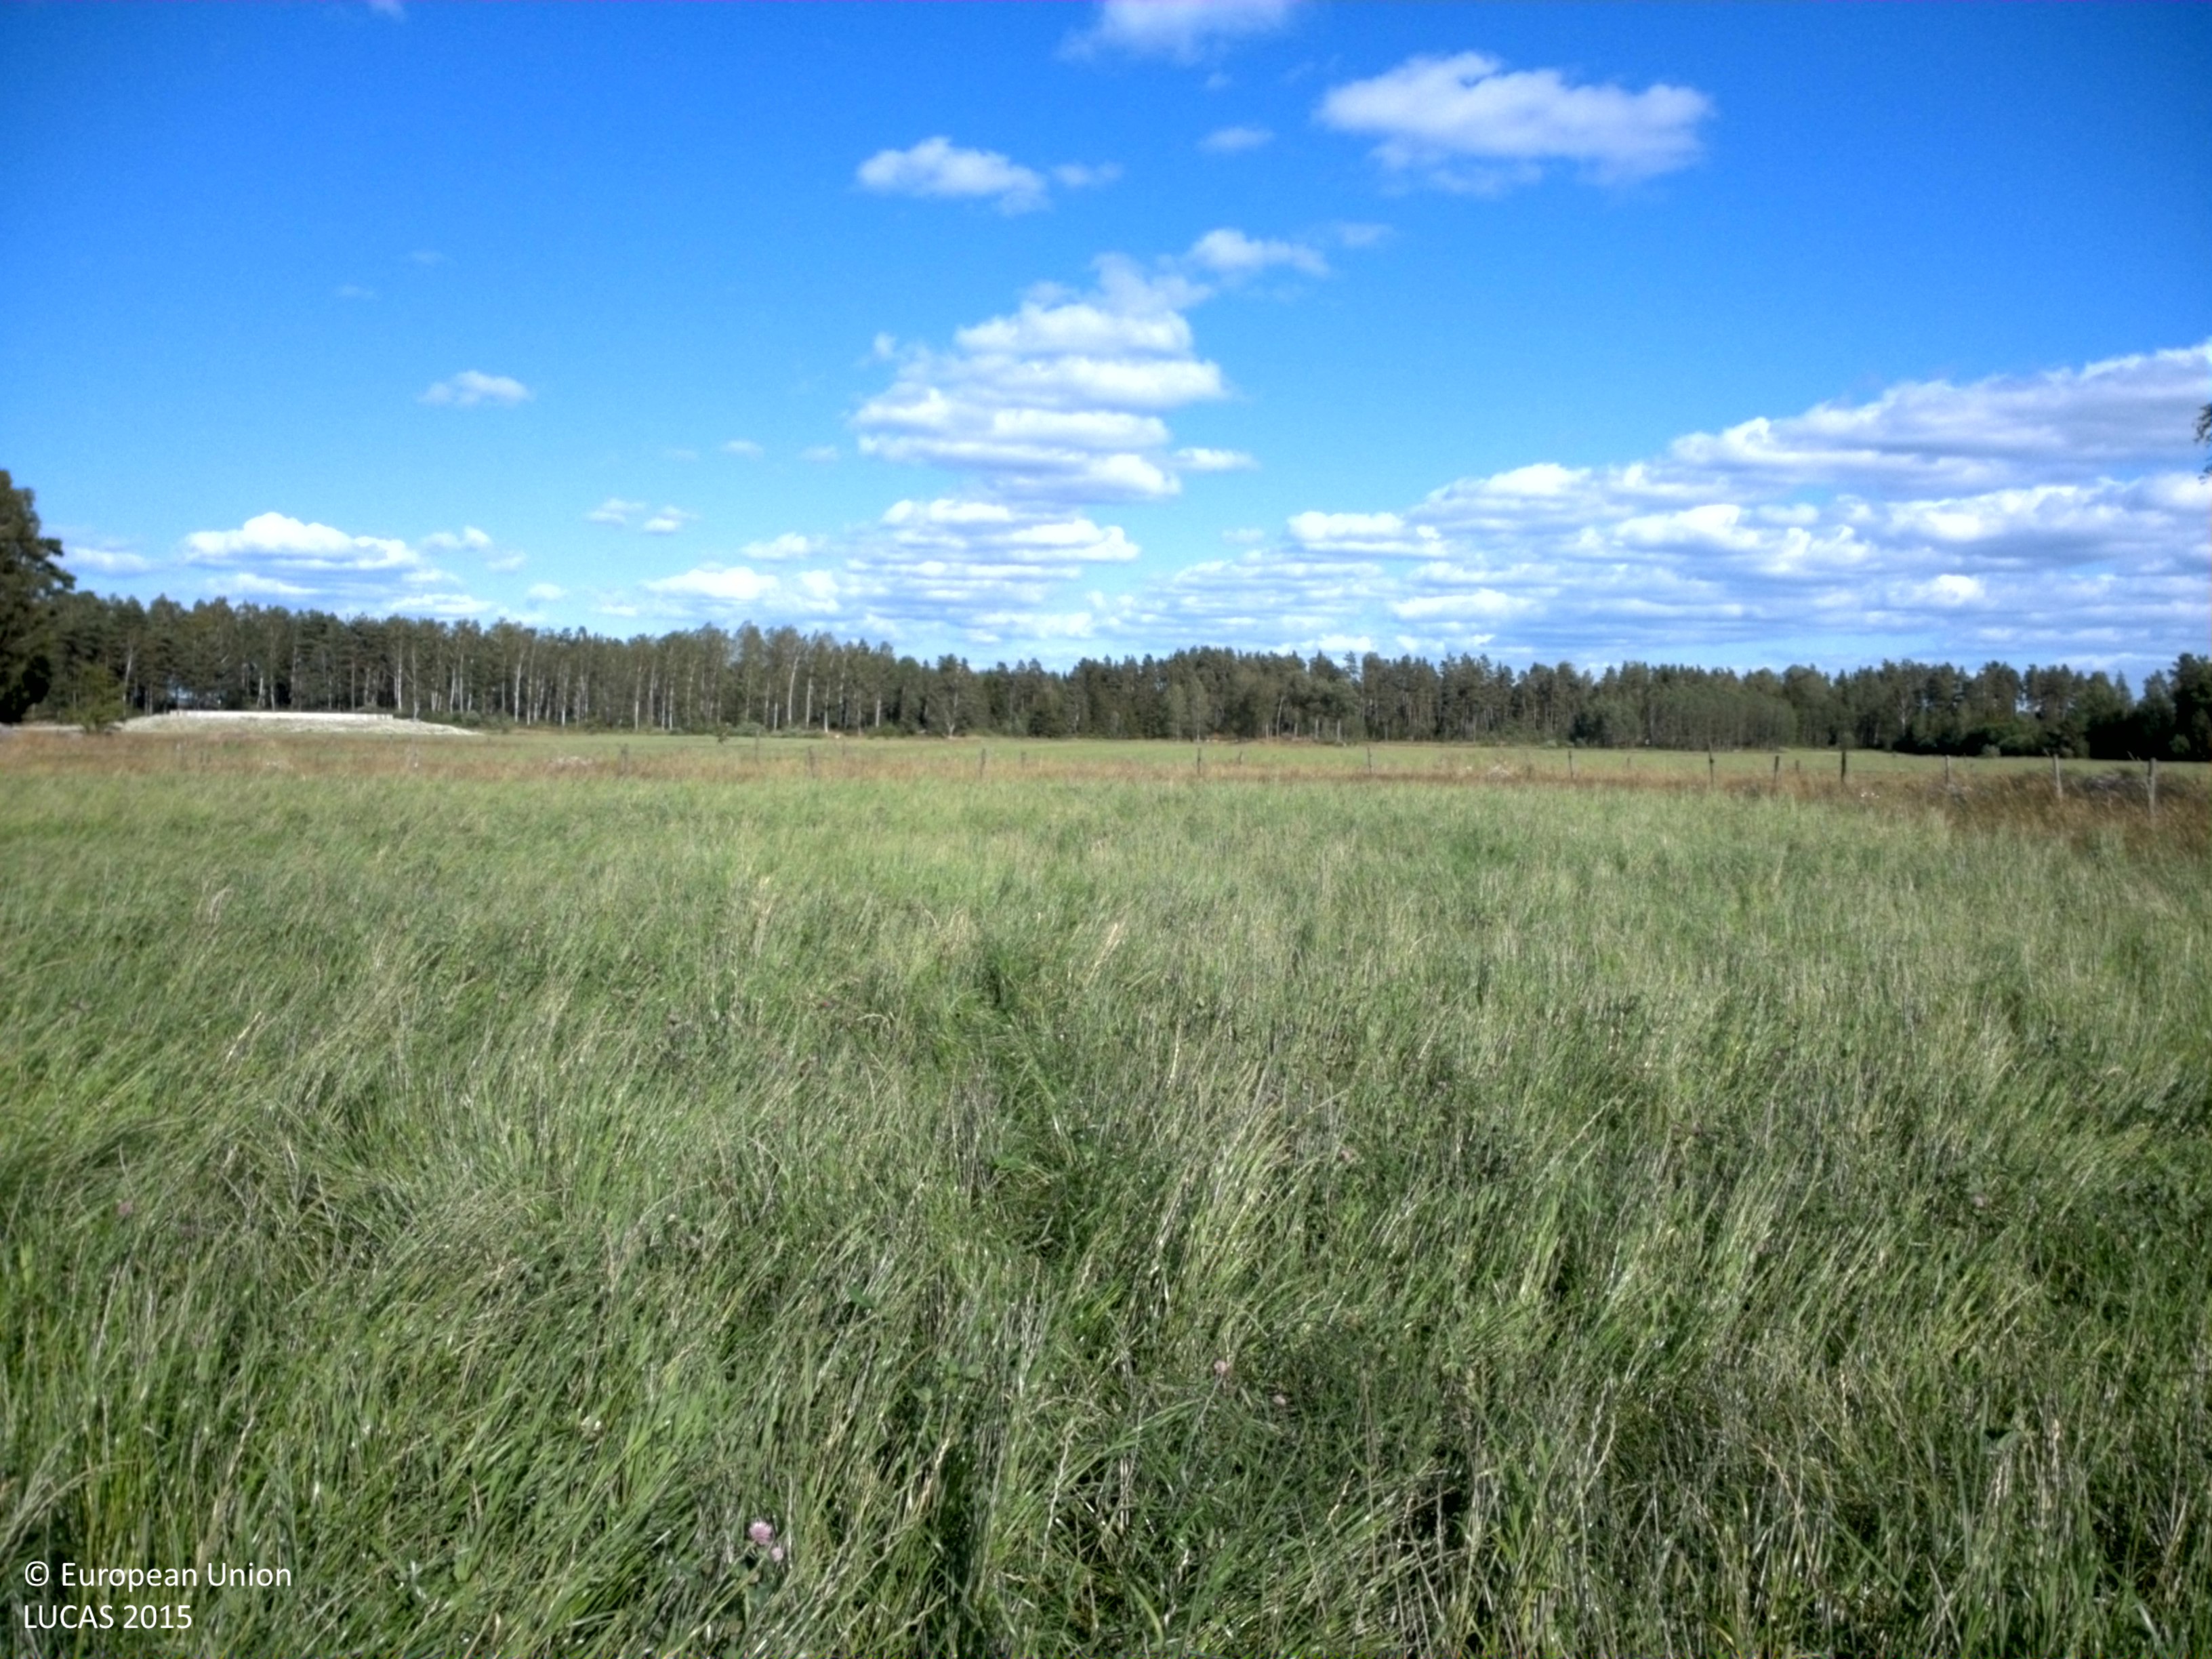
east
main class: Cropland
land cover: Temporary grasslands
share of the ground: > 75 %
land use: Agriculture (excluding fallow land and kitchen gardens)
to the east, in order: Temporary grasslands; Fences; Temporary grasslands; Fences; Temporary grasslands
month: July
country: SE
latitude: 58.6272
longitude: 14.0403
